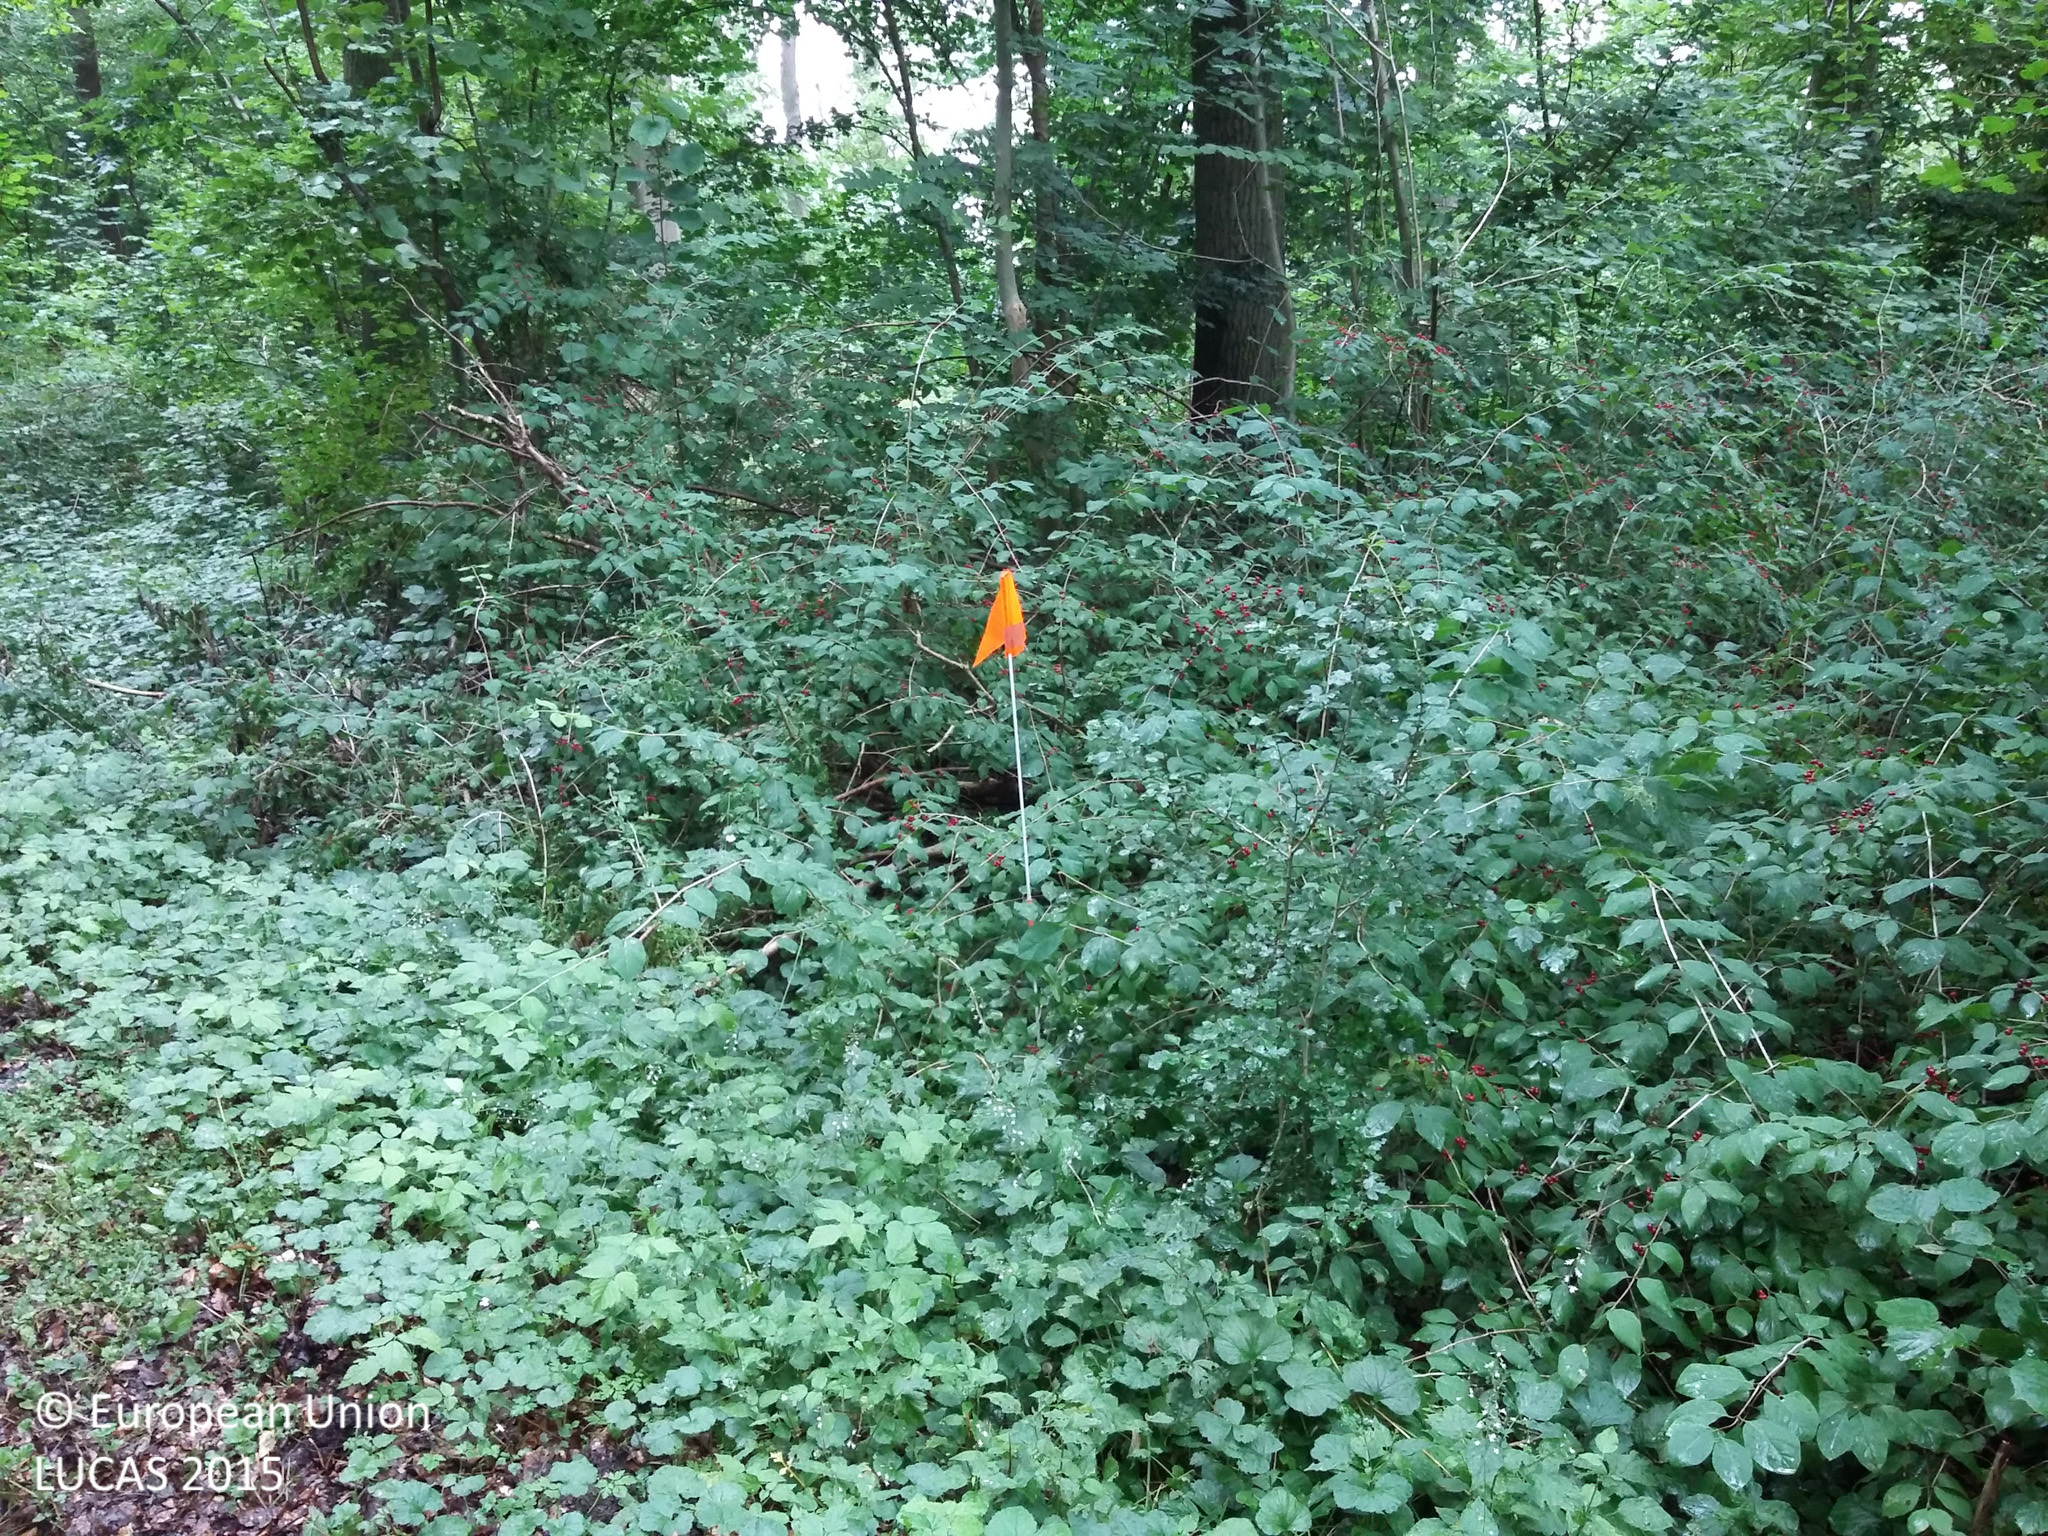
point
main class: Woodland
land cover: Broadleaved woodland
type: mesophytic deciduous forest
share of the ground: > 75 %
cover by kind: broadleaved forest trees 65 %, shrubs 35 %
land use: Forestry
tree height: > 5 m
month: August
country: DK
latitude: 55.3245
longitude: 12.1576
